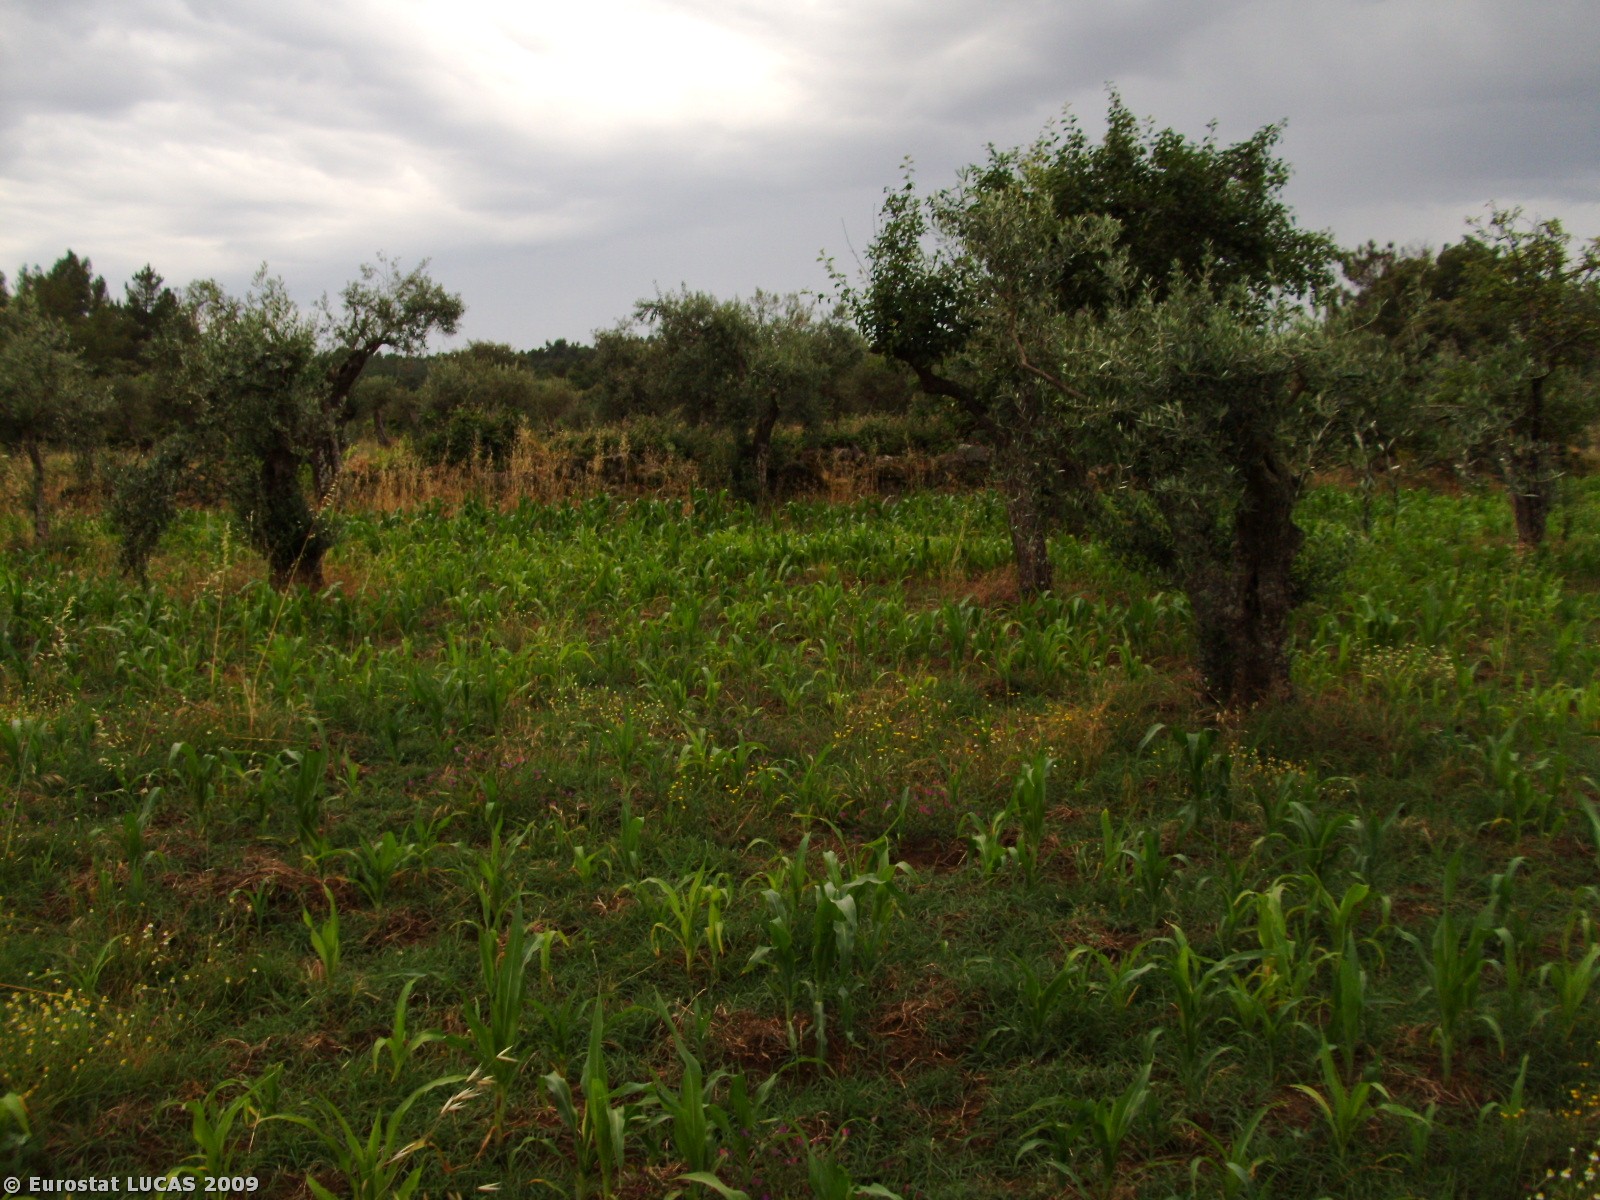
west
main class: Cropland
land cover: Olive groves
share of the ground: 25 - 50 %
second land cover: Maize
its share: 50 - 75 %
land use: Agriculture (excluding fallow land and kitchen gardens)
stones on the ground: > 50 %
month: June
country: PT
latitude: 39.9530
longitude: -7.5074
